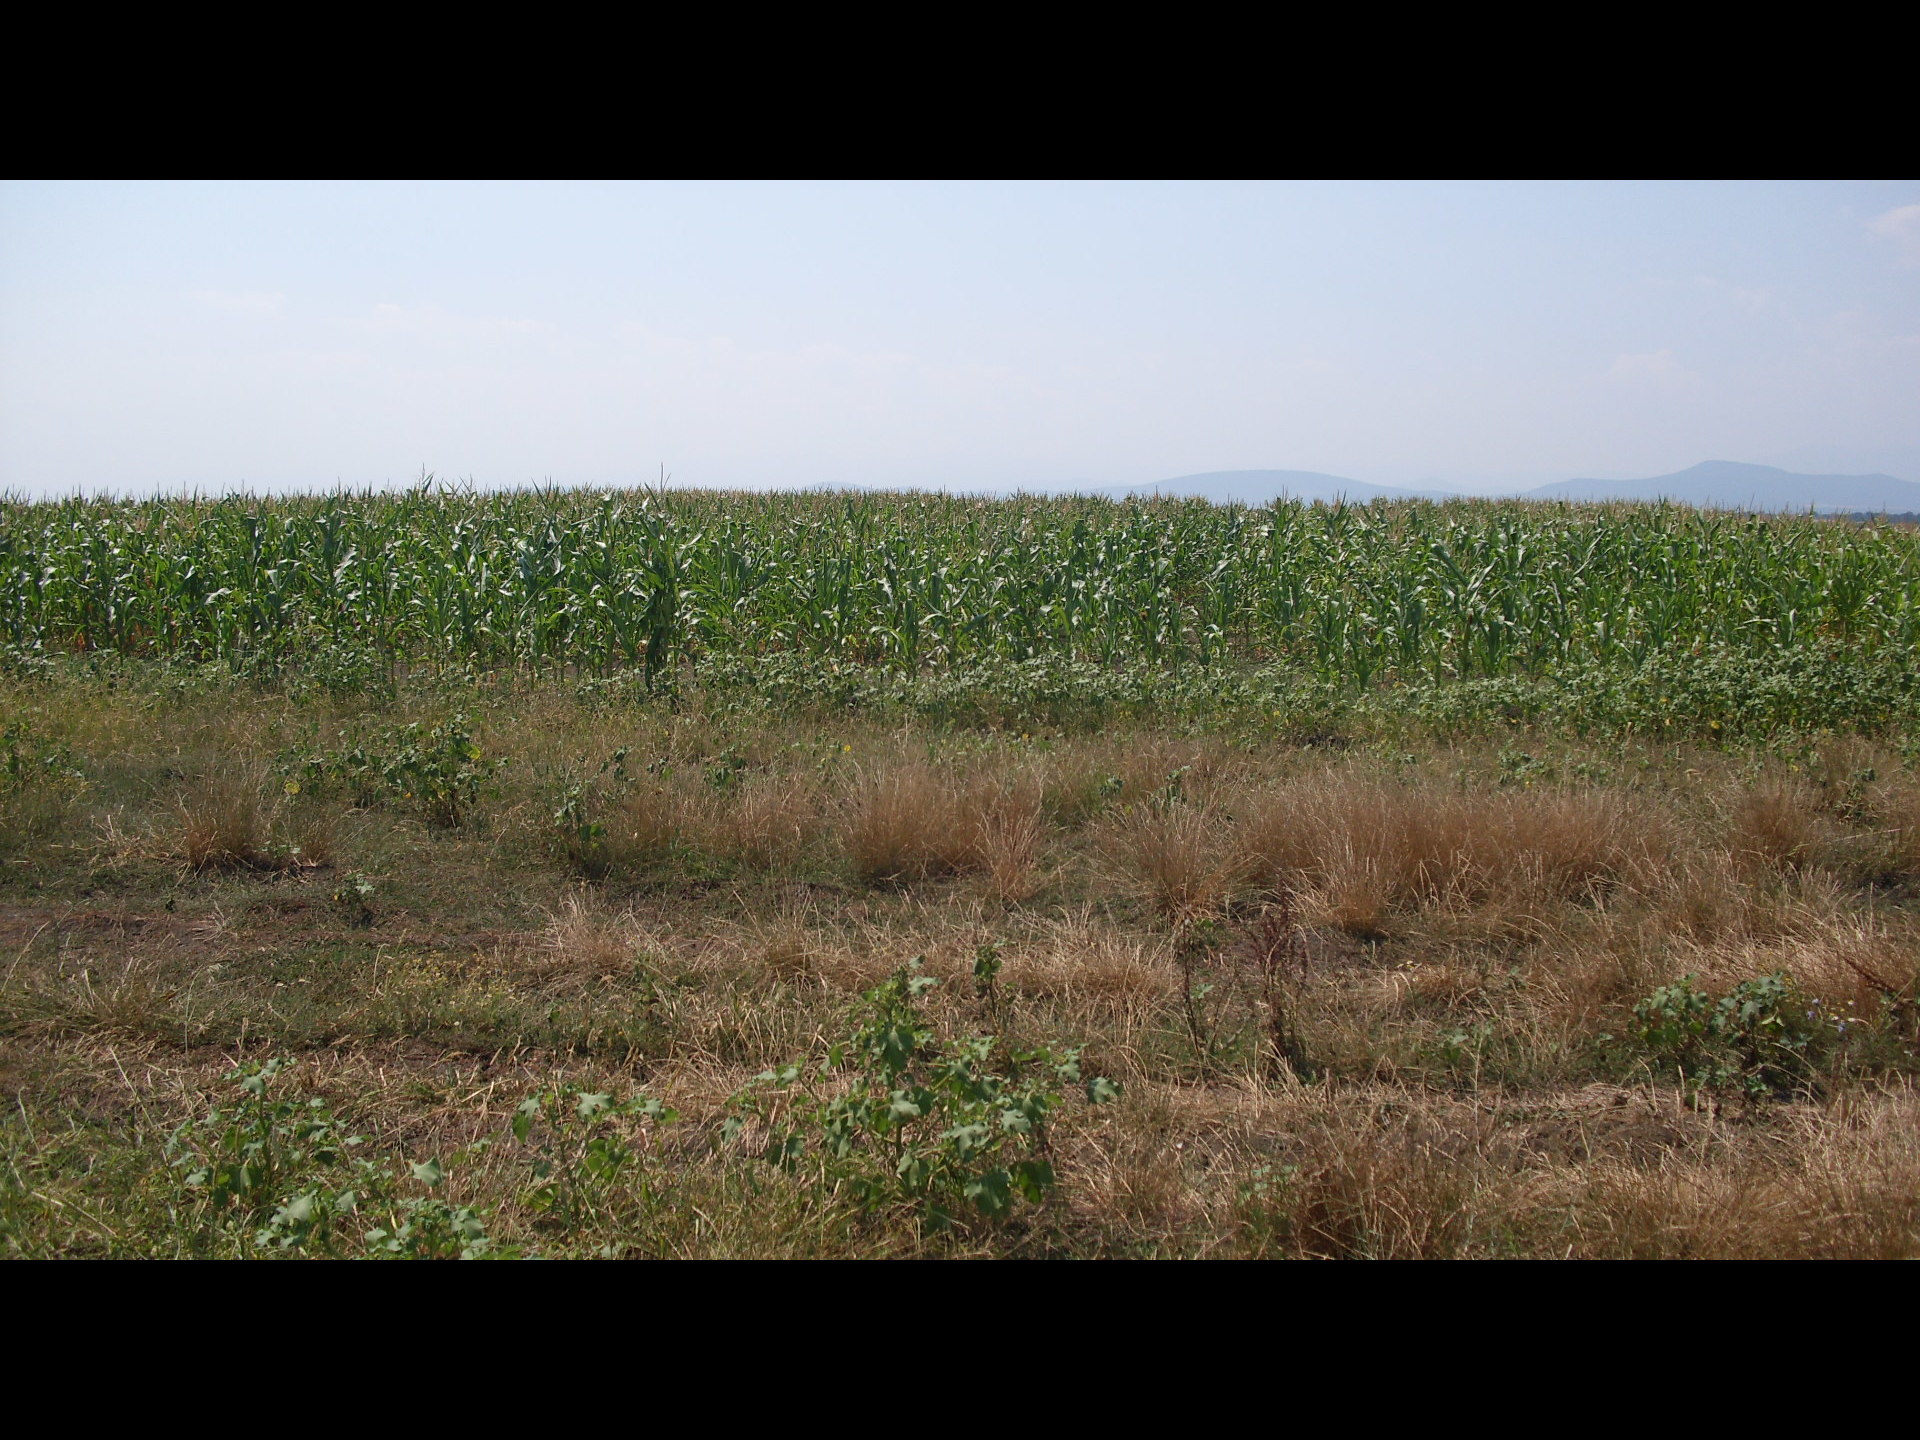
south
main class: Grassland
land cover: Spontaneously vegetated surfaces
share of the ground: > 75 %
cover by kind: herbaceous plants 100 %
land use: Agriculture (excluding fallow land and kitchen gardens)
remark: Harvested field
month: July
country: BG
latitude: 43.5997
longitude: 23.1591
